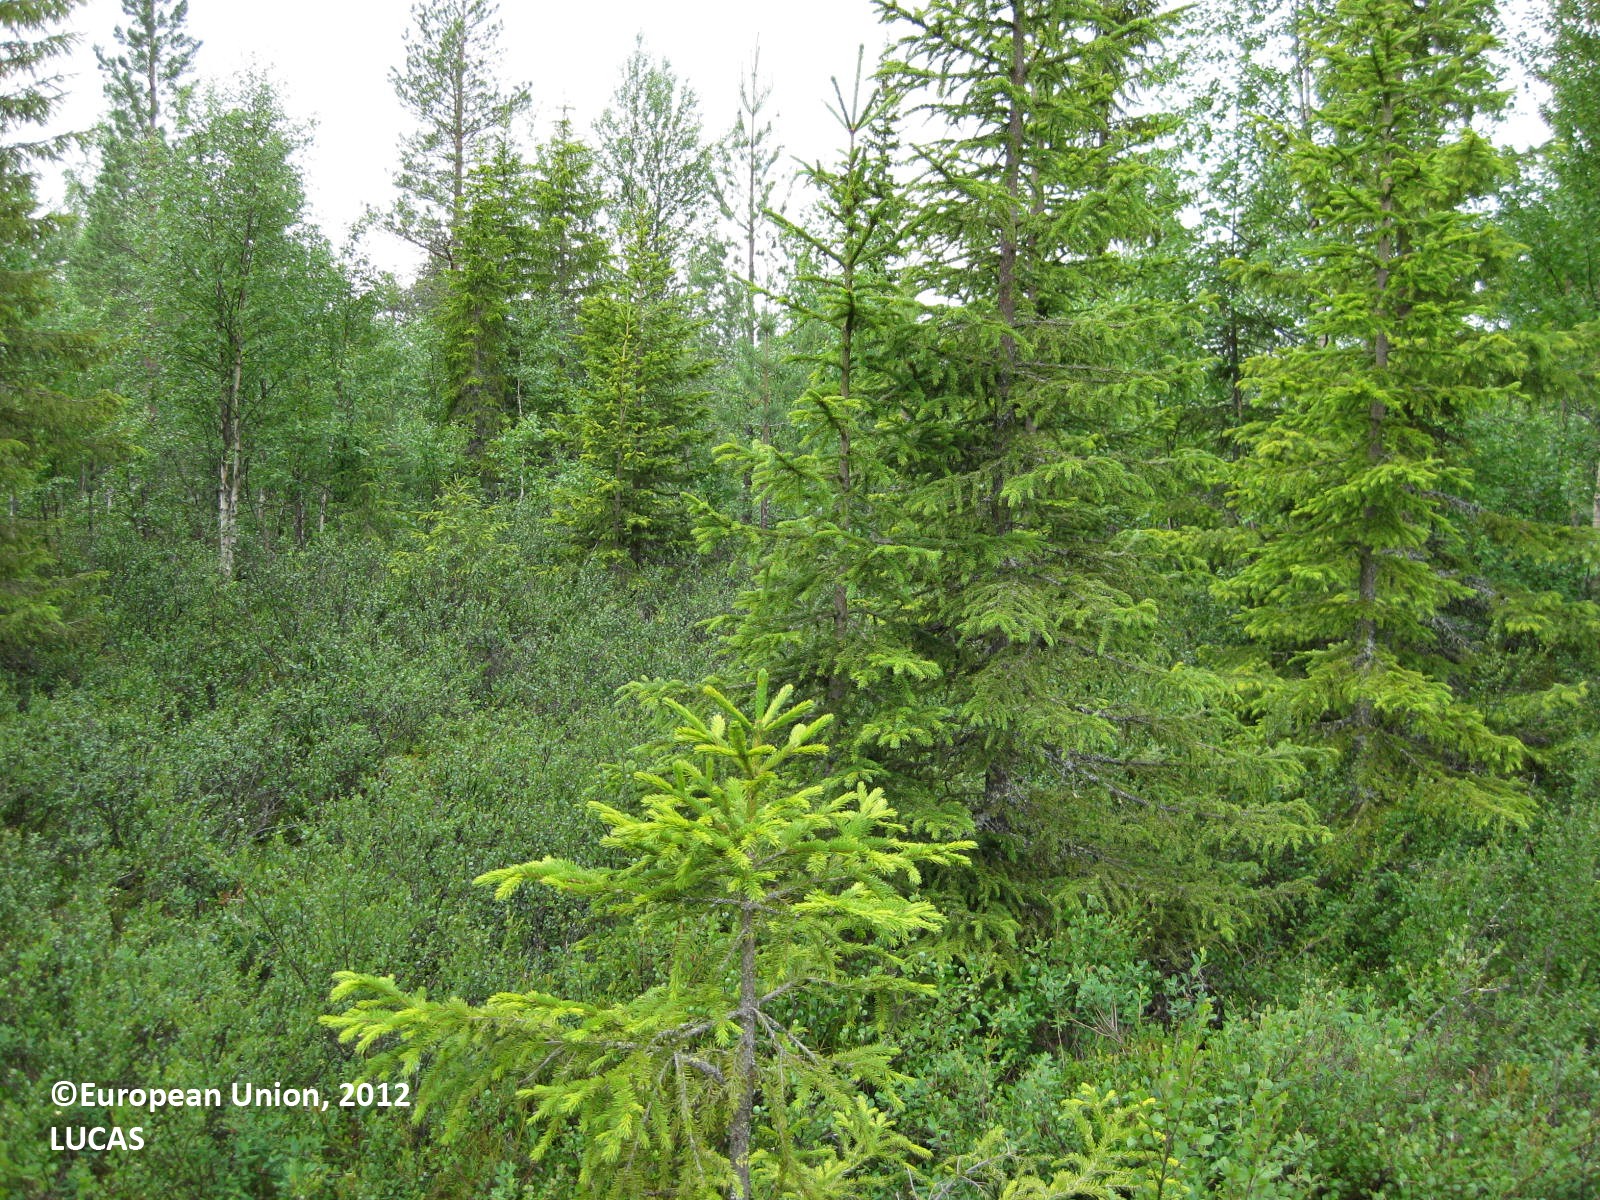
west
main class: Woodland
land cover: Other mixed woodland
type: boreal forest
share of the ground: 25 - 50 %
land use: Forestry
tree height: > 5 m
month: July
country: FI
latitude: 65.4216
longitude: 28.3651
